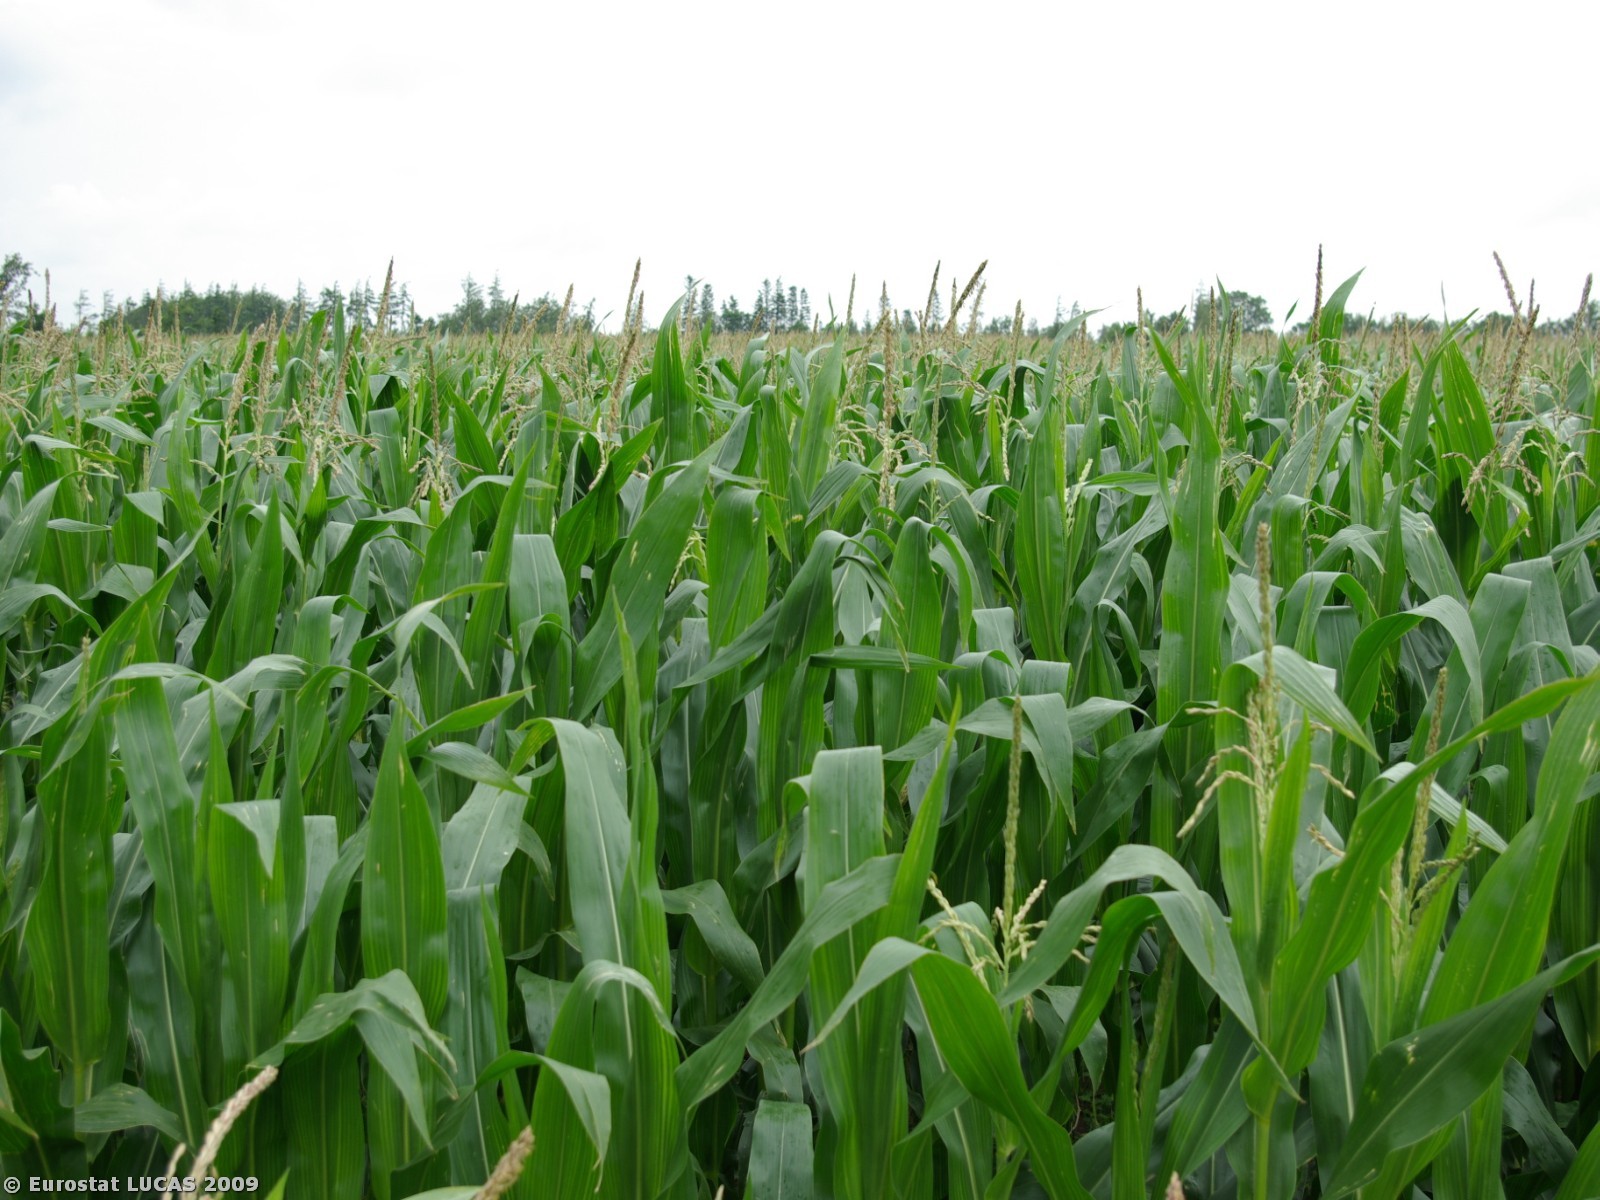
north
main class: Cropland
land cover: Maize
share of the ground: > 75 %
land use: Agriculture (excluding fallow land and kitchen gardens)
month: July
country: DK
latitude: 55.1223
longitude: 8.8876
